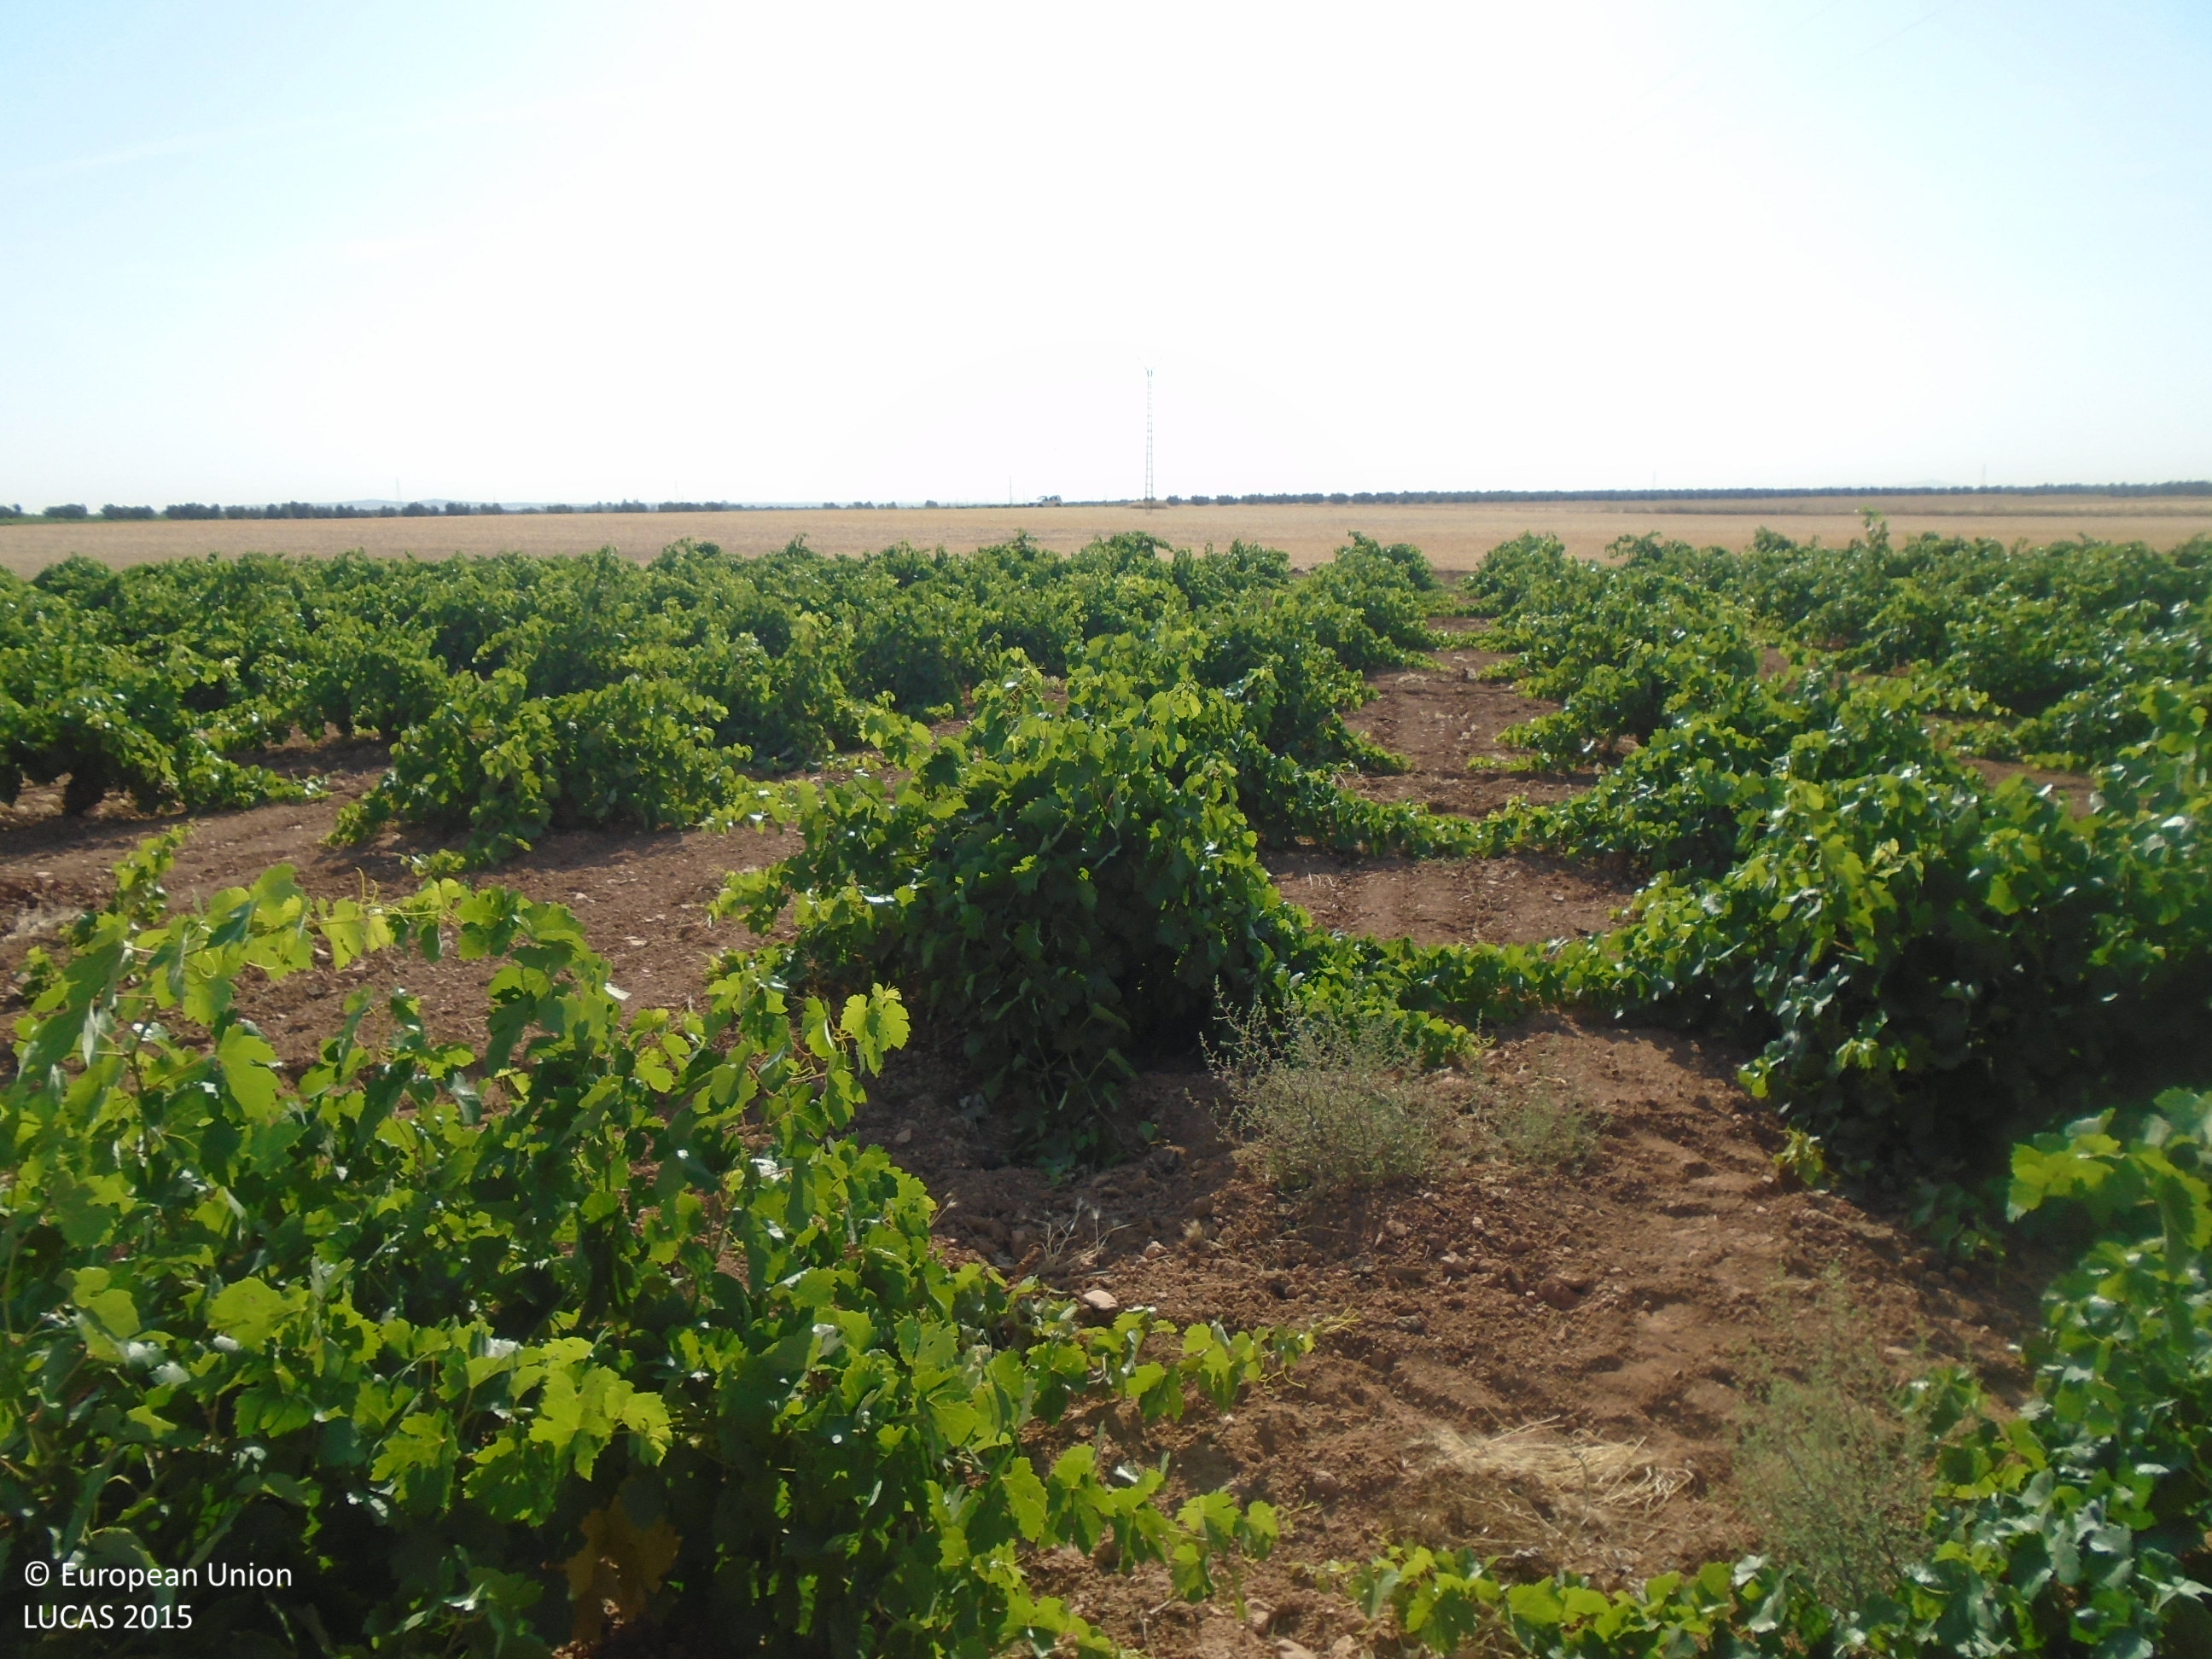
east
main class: Cropland
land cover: Vineyards
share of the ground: 10 - 25 %
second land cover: Other bare soil
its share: > 75 %
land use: Agriculture (excluding fallow land and kitchen gardens)
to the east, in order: Vineyards; Other bare soil; Grass margins; Oats; Electric lines; Oats; Grass margins; Tracks; Grass margins; Oats
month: July
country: ES
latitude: 39.3991
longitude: -3.5266
